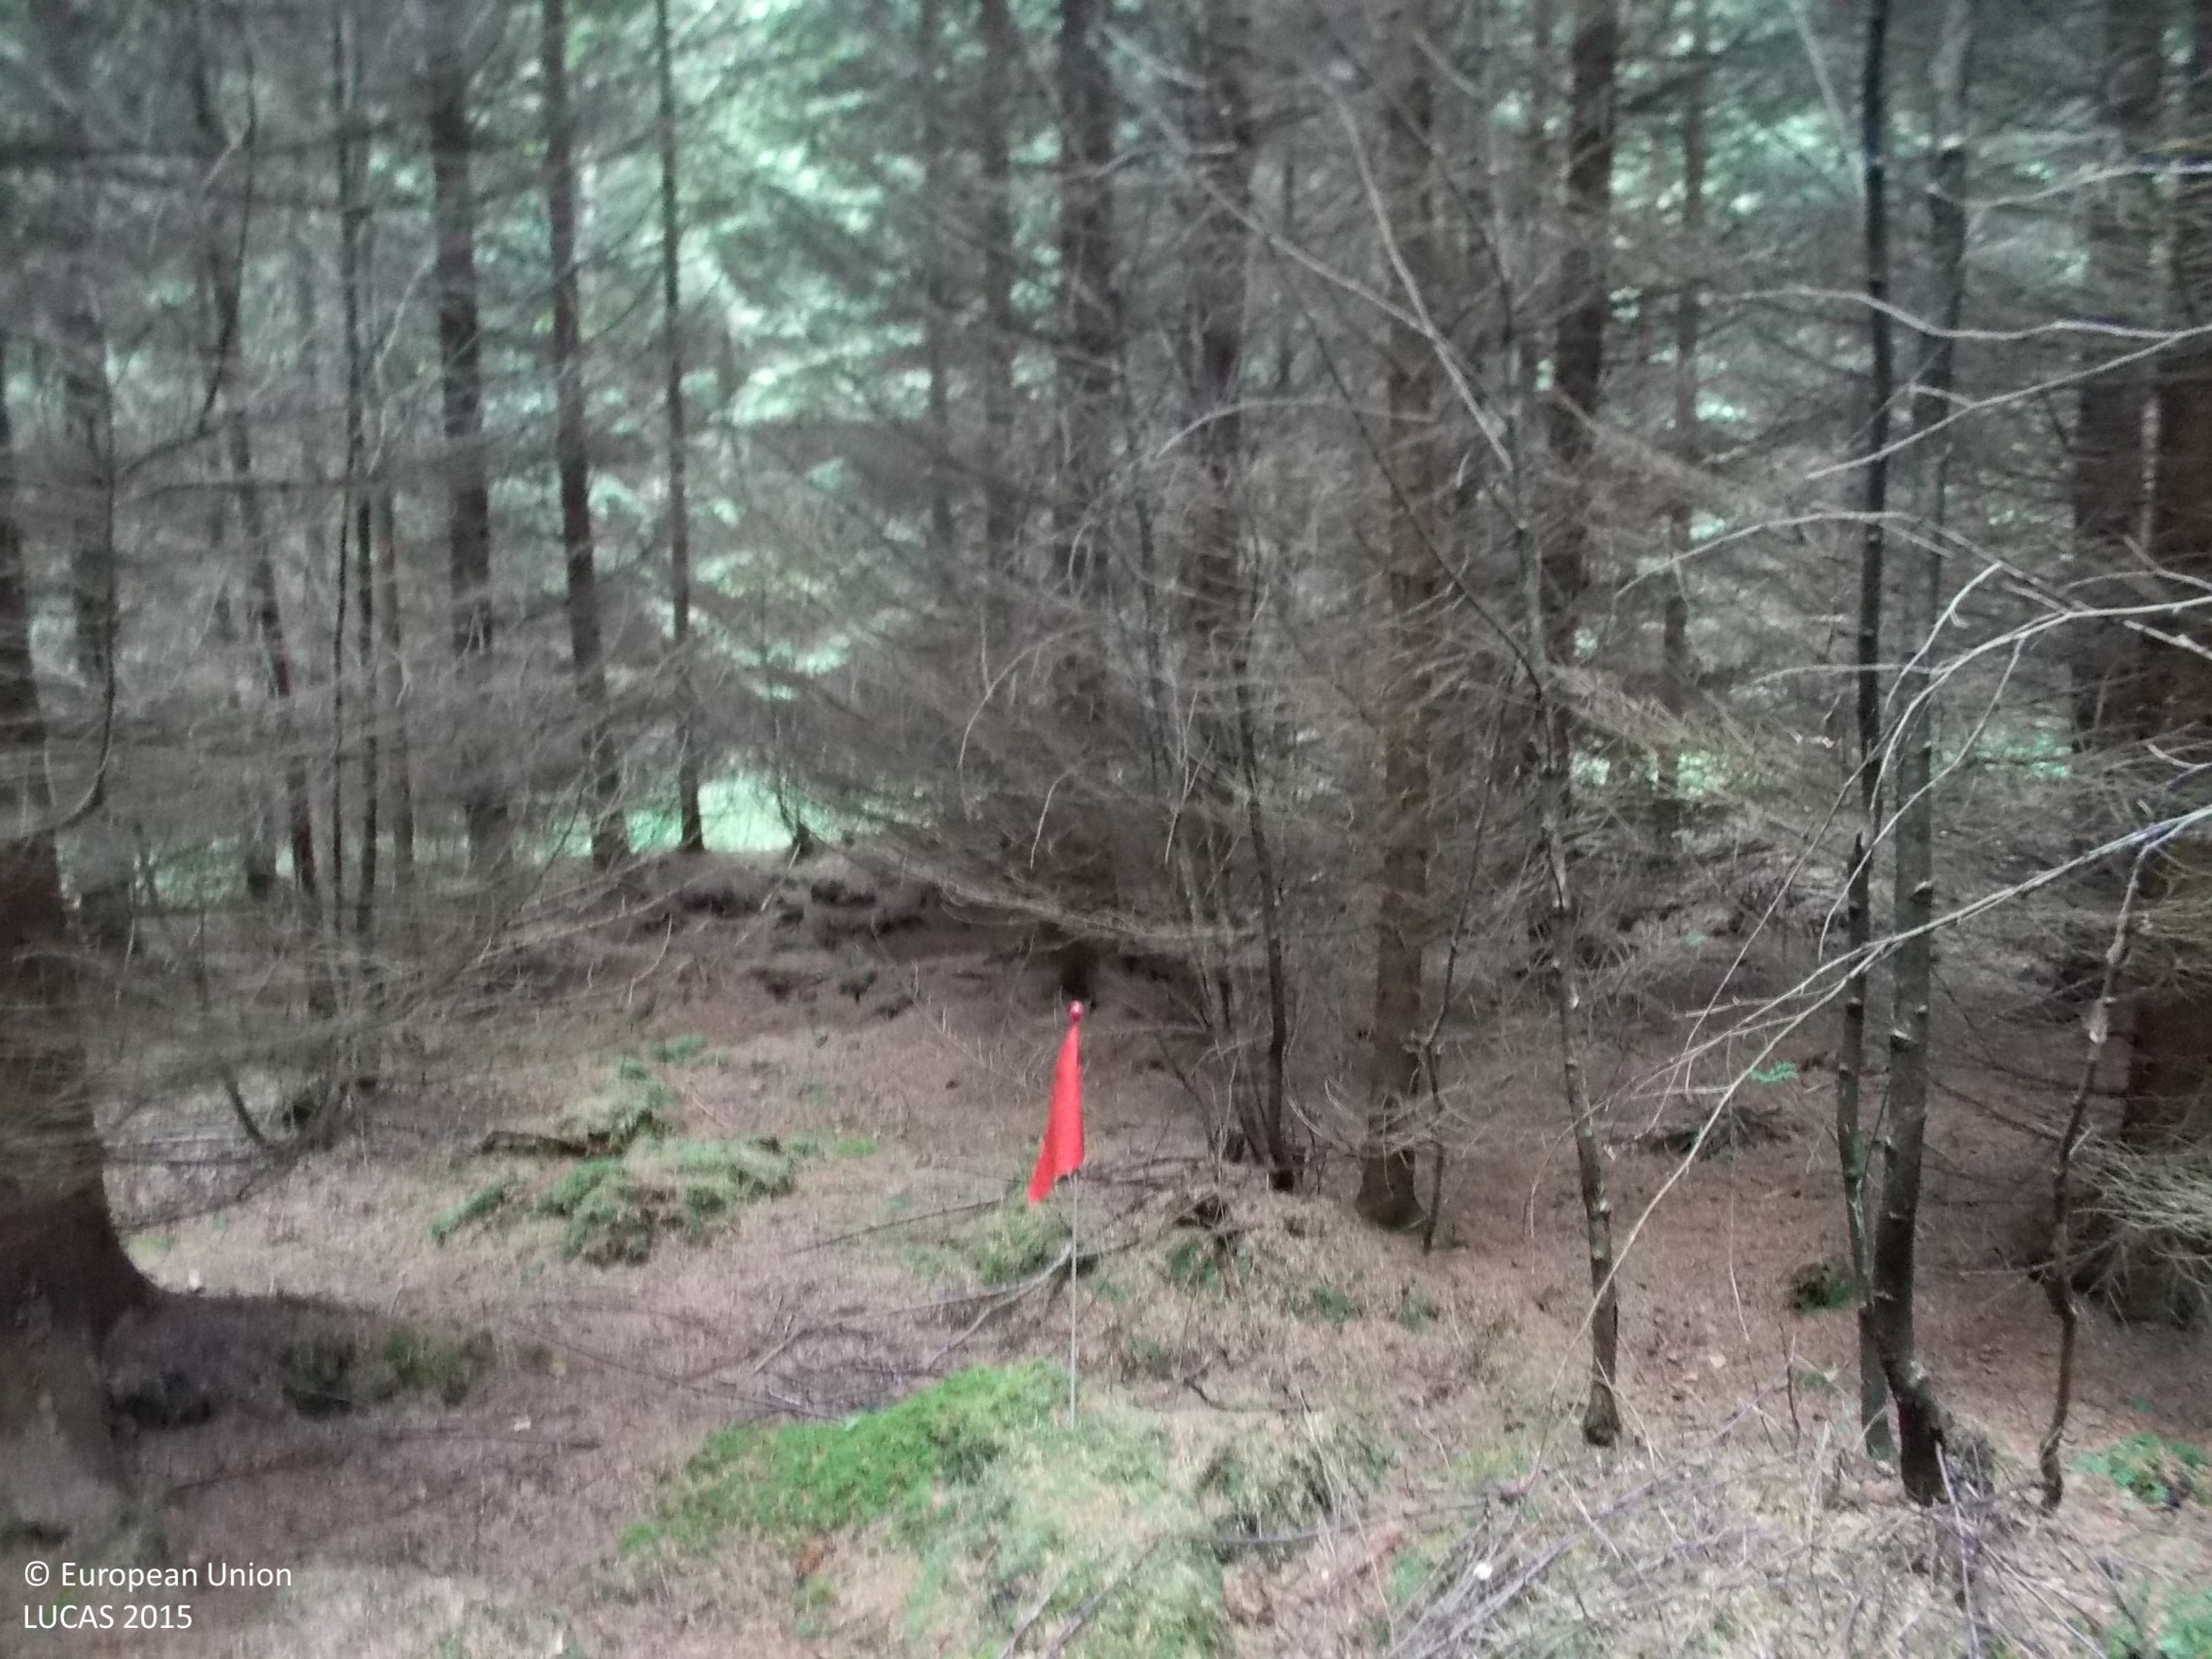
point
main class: Woodland
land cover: Spruce dominated coniferous woodland
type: boreal forest
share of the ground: > 75 %
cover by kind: coniferous forest trees 95 %, lichens and mosses 5 %
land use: Forestry
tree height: > 5 m
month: July
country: SE
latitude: 57.3193
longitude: 12.2384
